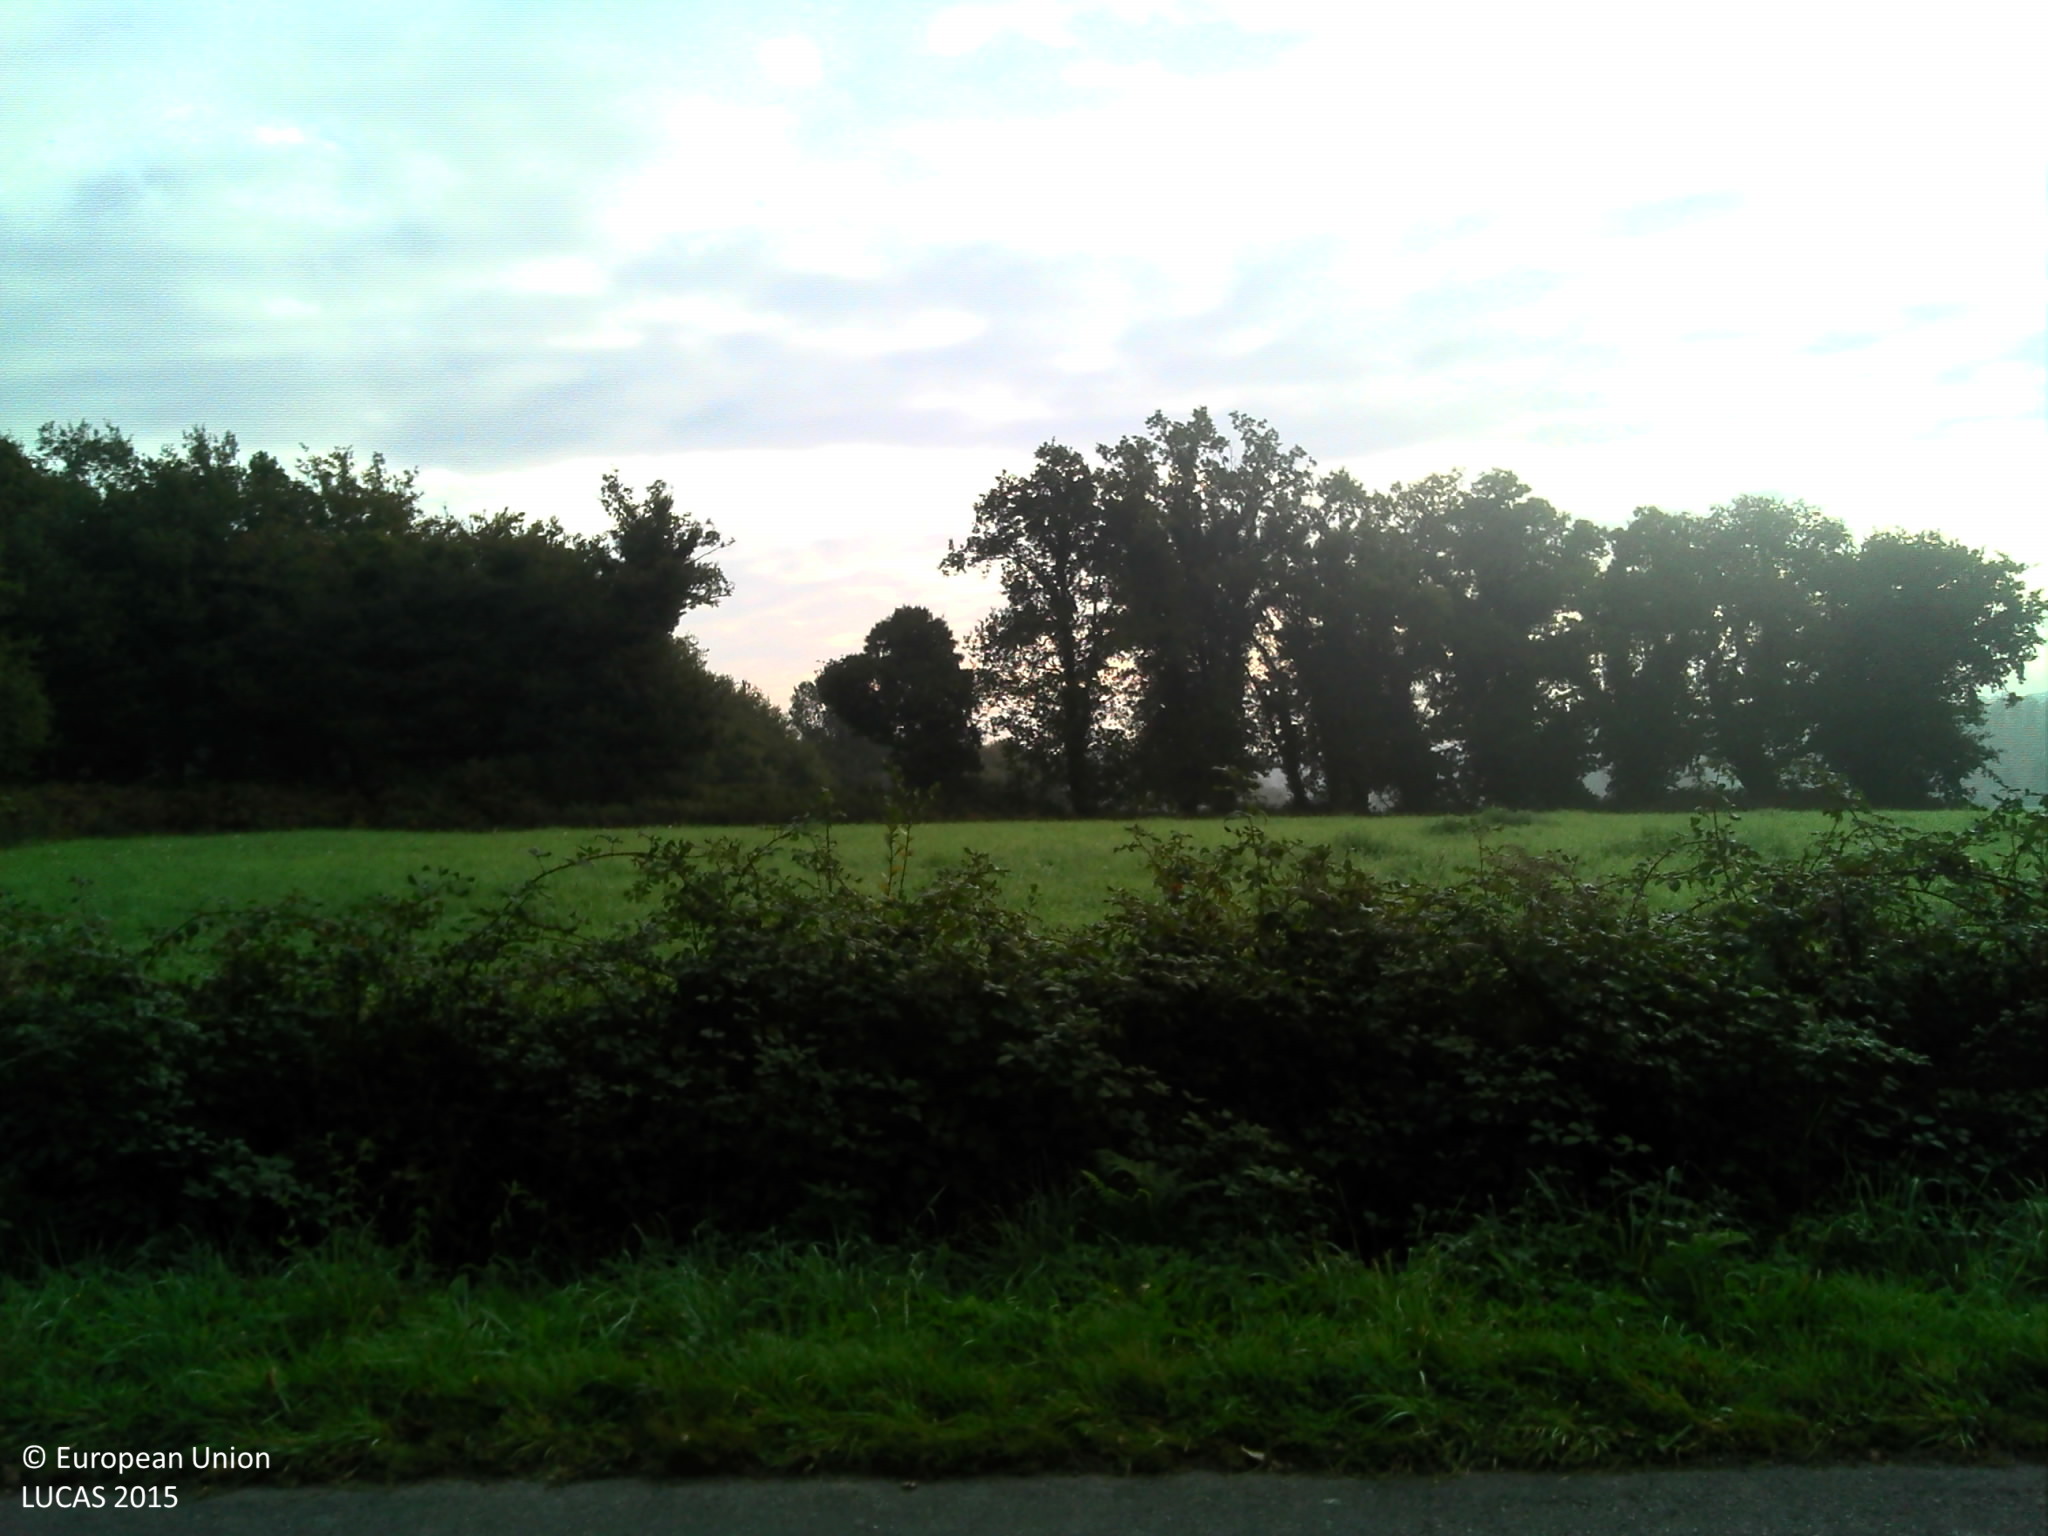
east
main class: Cropland
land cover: Maize
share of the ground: > 75 %
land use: Agriculture (excluding fallow land and kitchen gardens)
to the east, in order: Maize; Ditches and canals; Electric lines; Grass margins; Paved roads, cycling and walking lanes; Grass margins; Abandoned hedges; Temporary grasslands; Lines of trees; Temporary grasslands; Abandoned hedges; Ditches and canals; Grass margins; Paved roads, cycling and walking lanes; Grass margins; Ditches and canals; Electric lines; Grass margins; Spontaneously vegetated surfaces; Pine dominated coniferous woodland
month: October
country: FR
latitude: 47.6246
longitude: -2.2831
